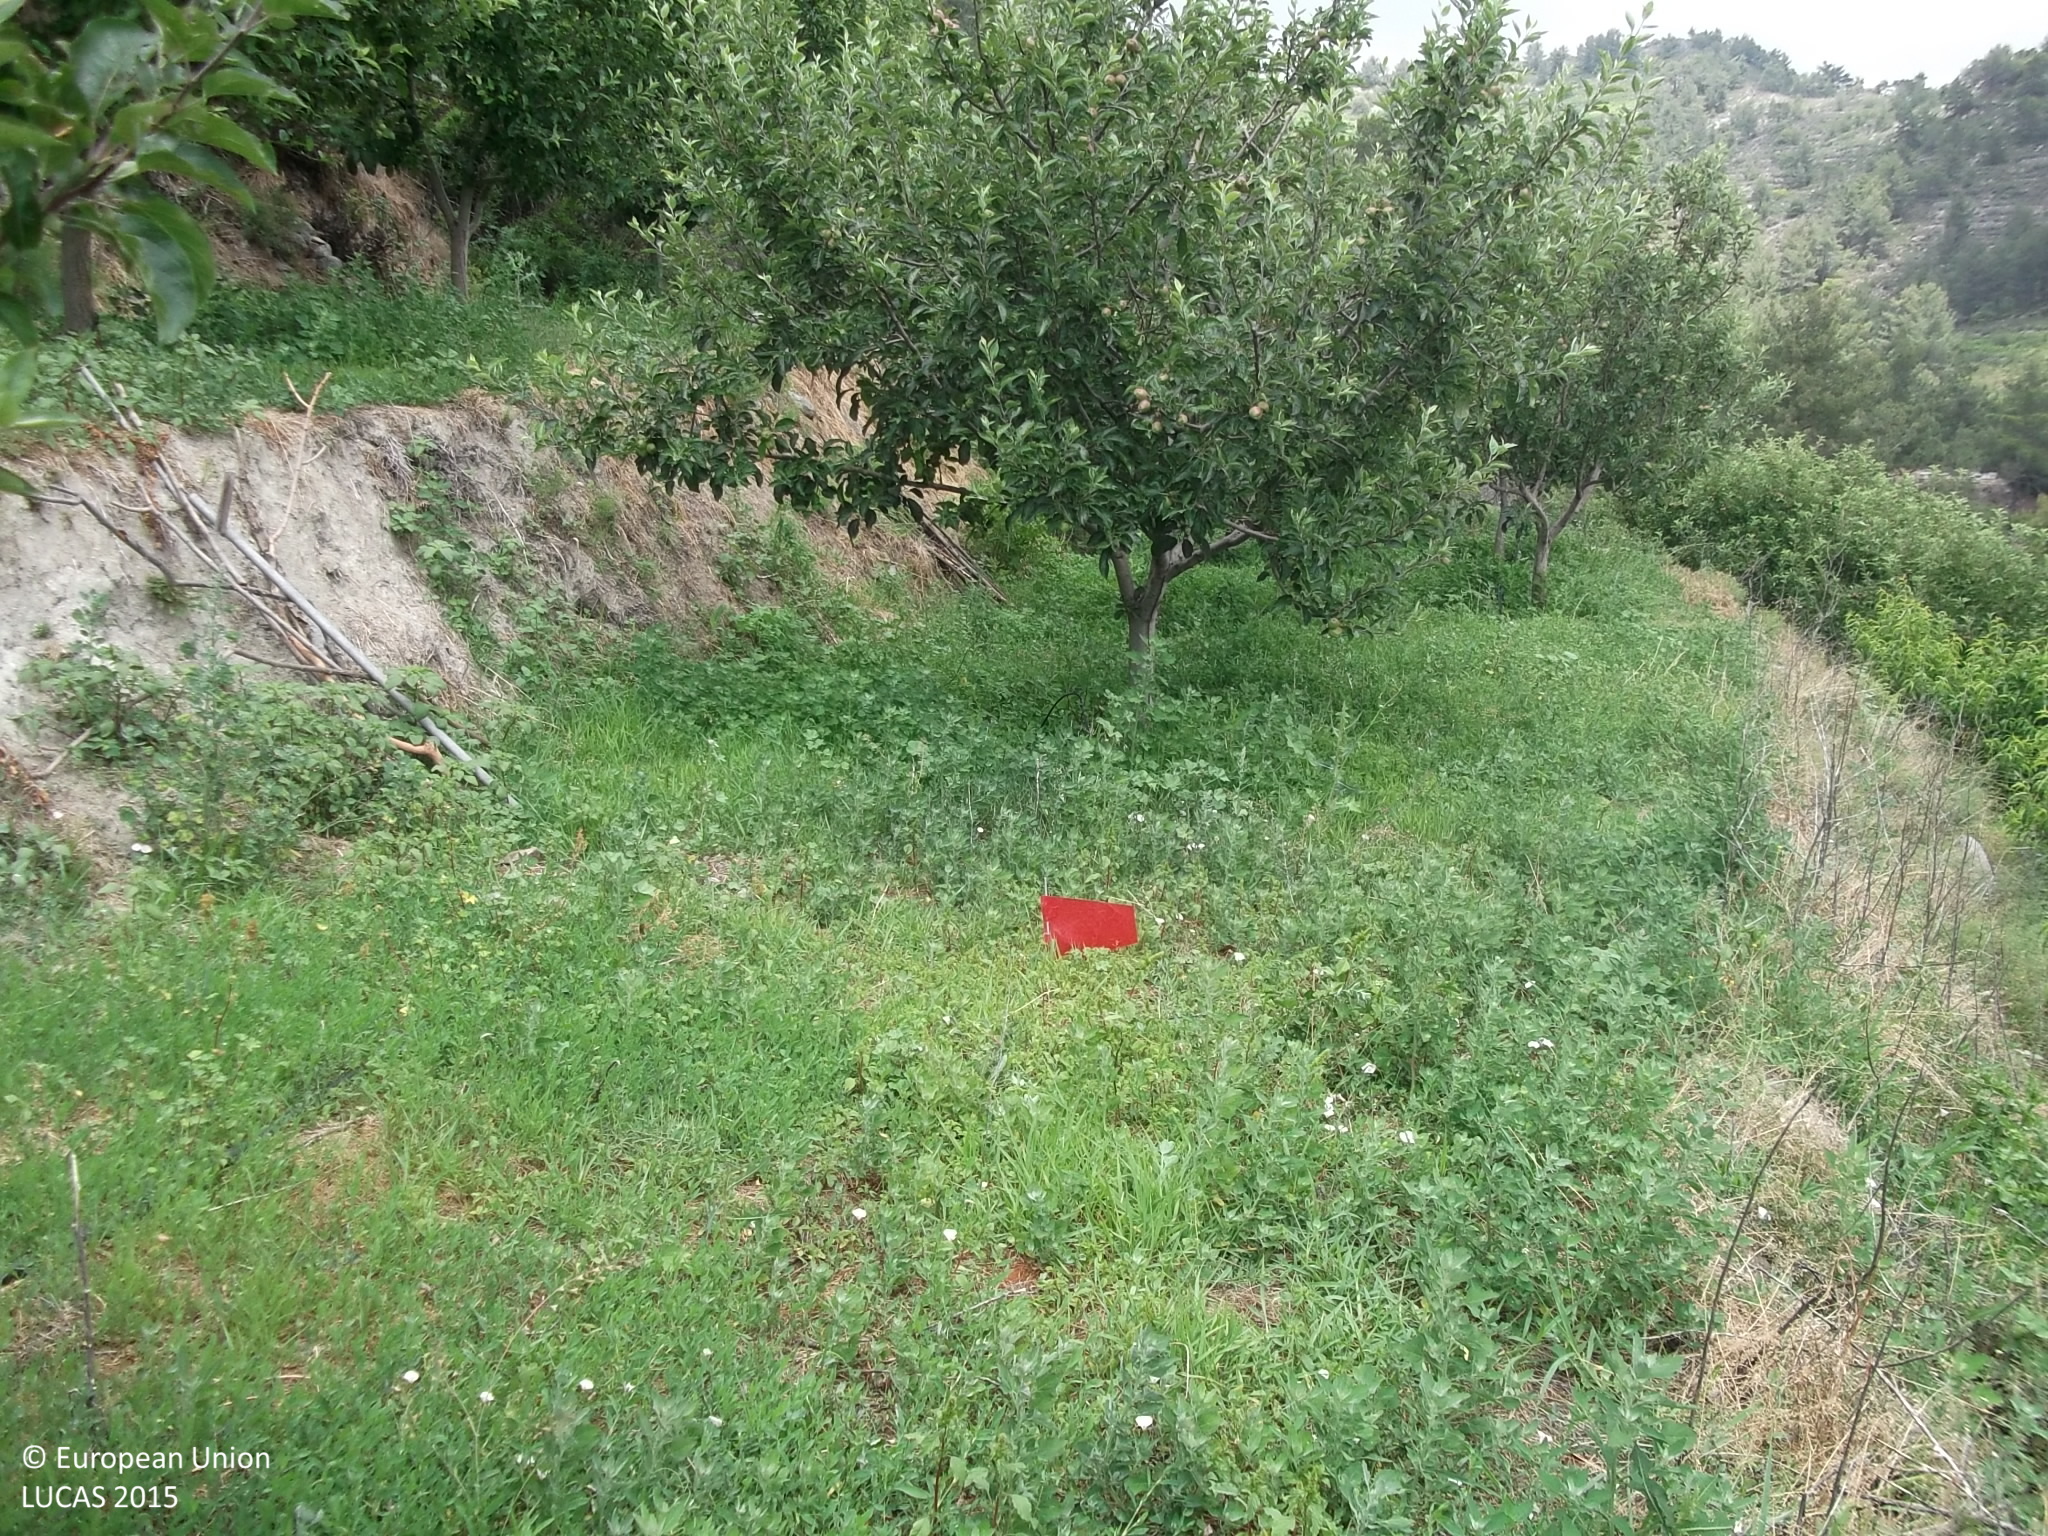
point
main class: Cropland
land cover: Apple fruit
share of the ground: 50 - 75 %
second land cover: Grassland without tree/shrub cover
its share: > 75 %
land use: Agriculture (excluding fallow land and kitchen gardens)
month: June
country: CY
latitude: 34.9144
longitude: 32.9690
